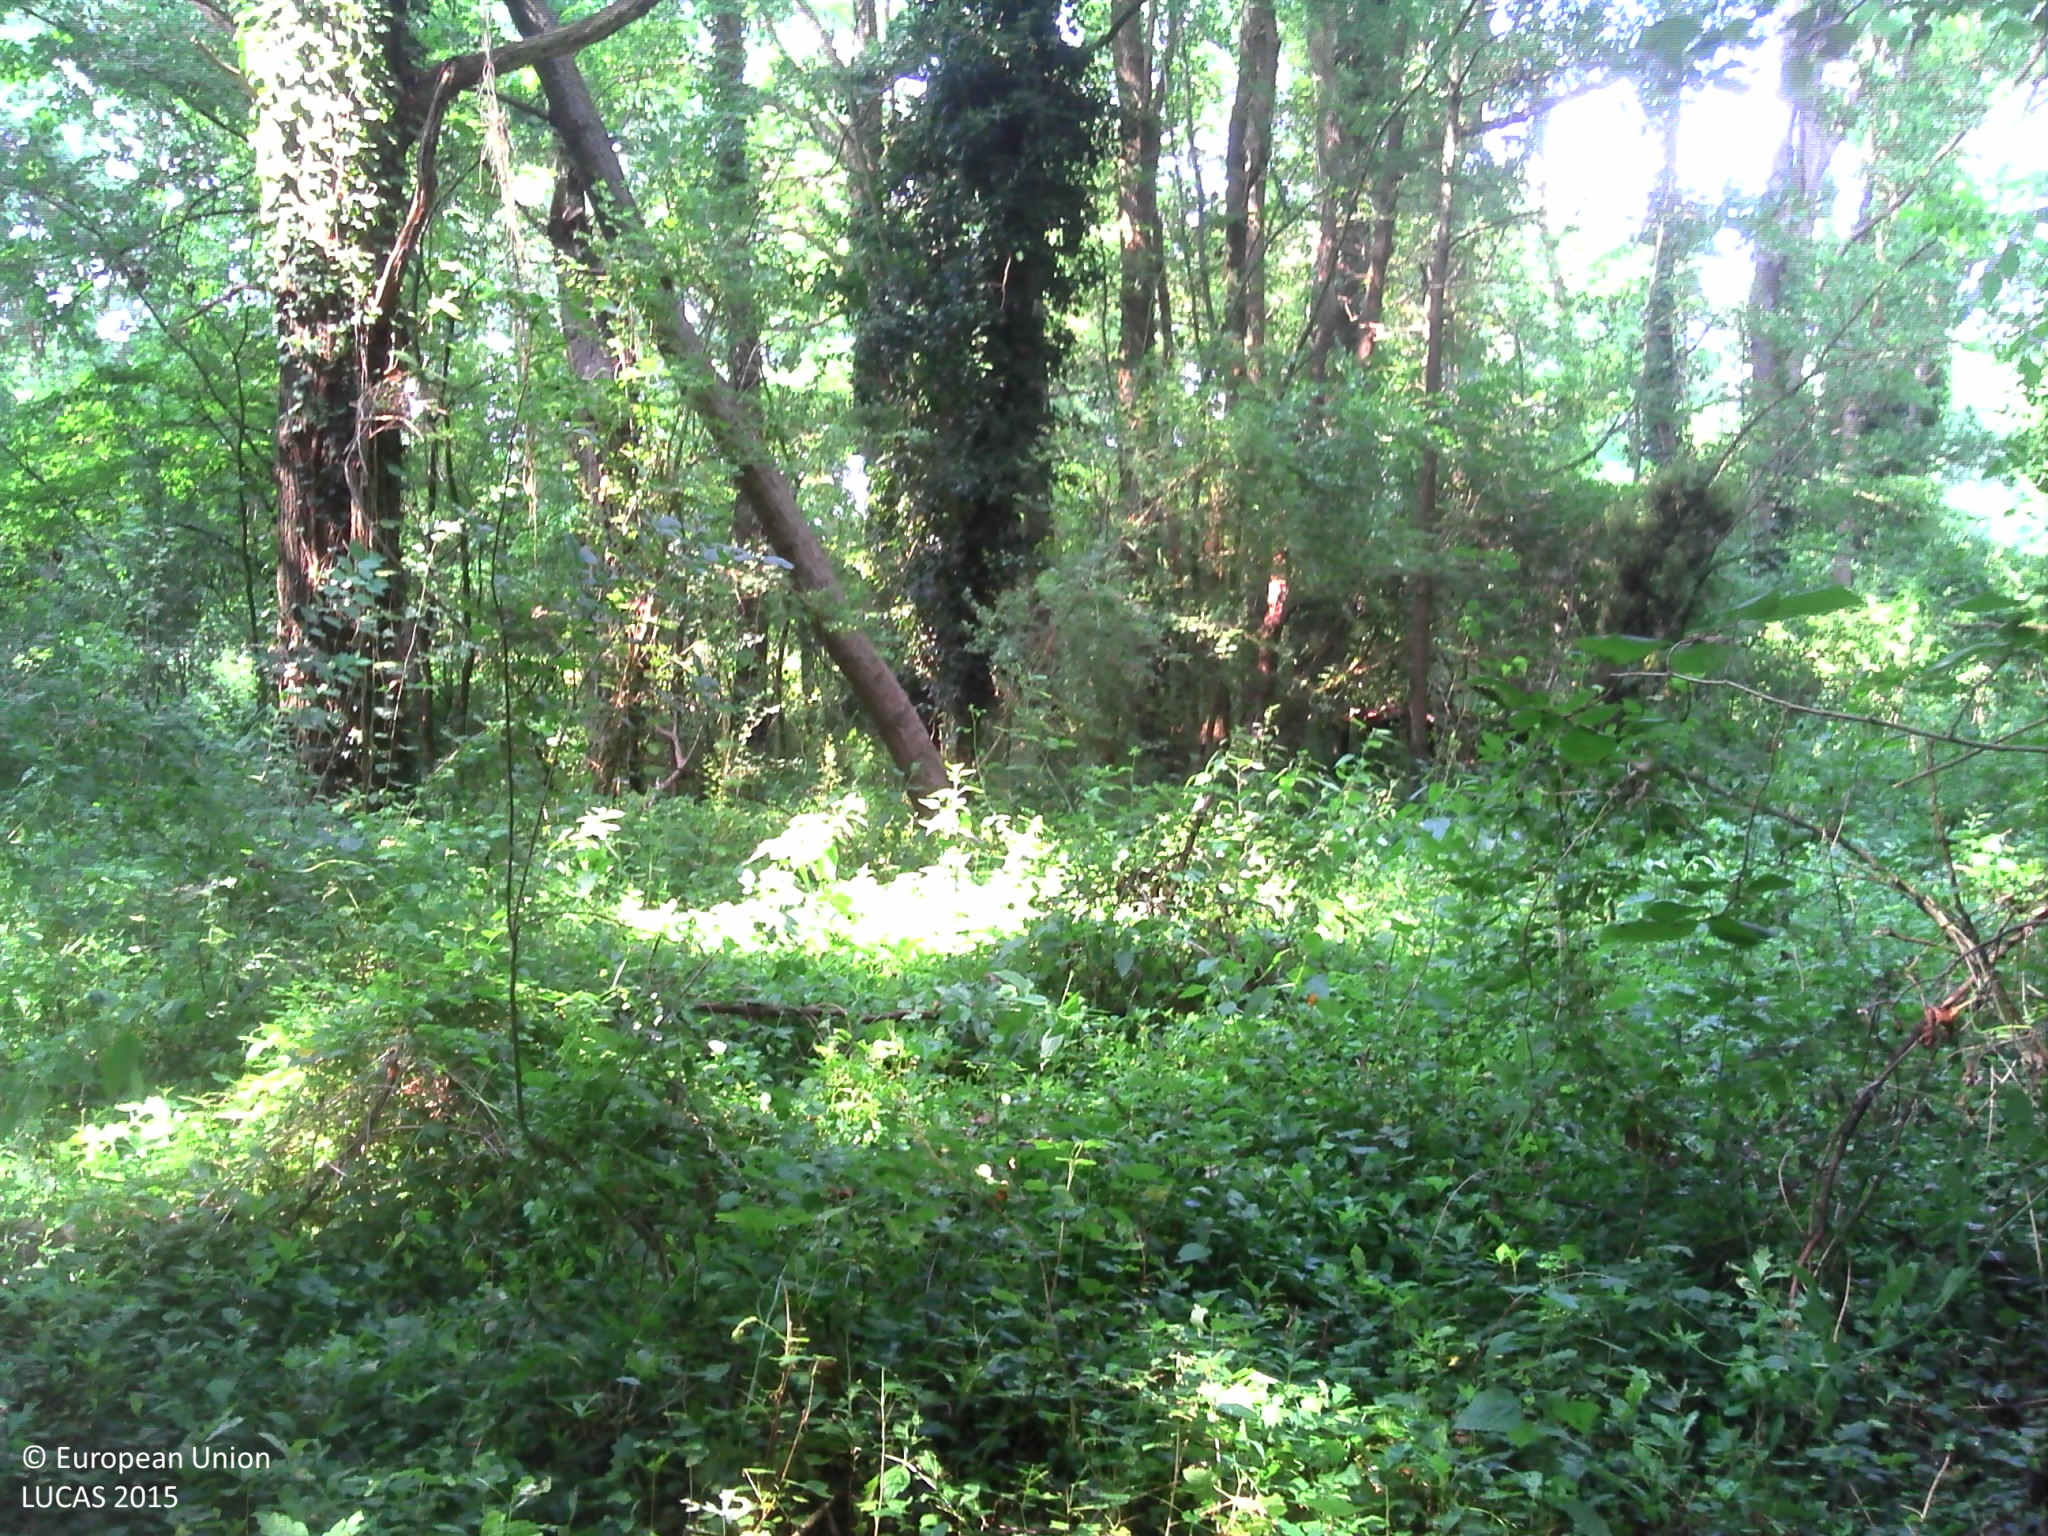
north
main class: Woodland
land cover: Broadleaved woodland
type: mesophytic deciduous forest
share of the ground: > 75 %
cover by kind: broadleaved forest trees 80 %, herbaceous plants 10 %, shrubs 5 %, lichens and mosses 5 %
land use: Forestry
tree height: > 5 m
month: July
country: FR
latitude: 47.2136
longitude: 0.0864
